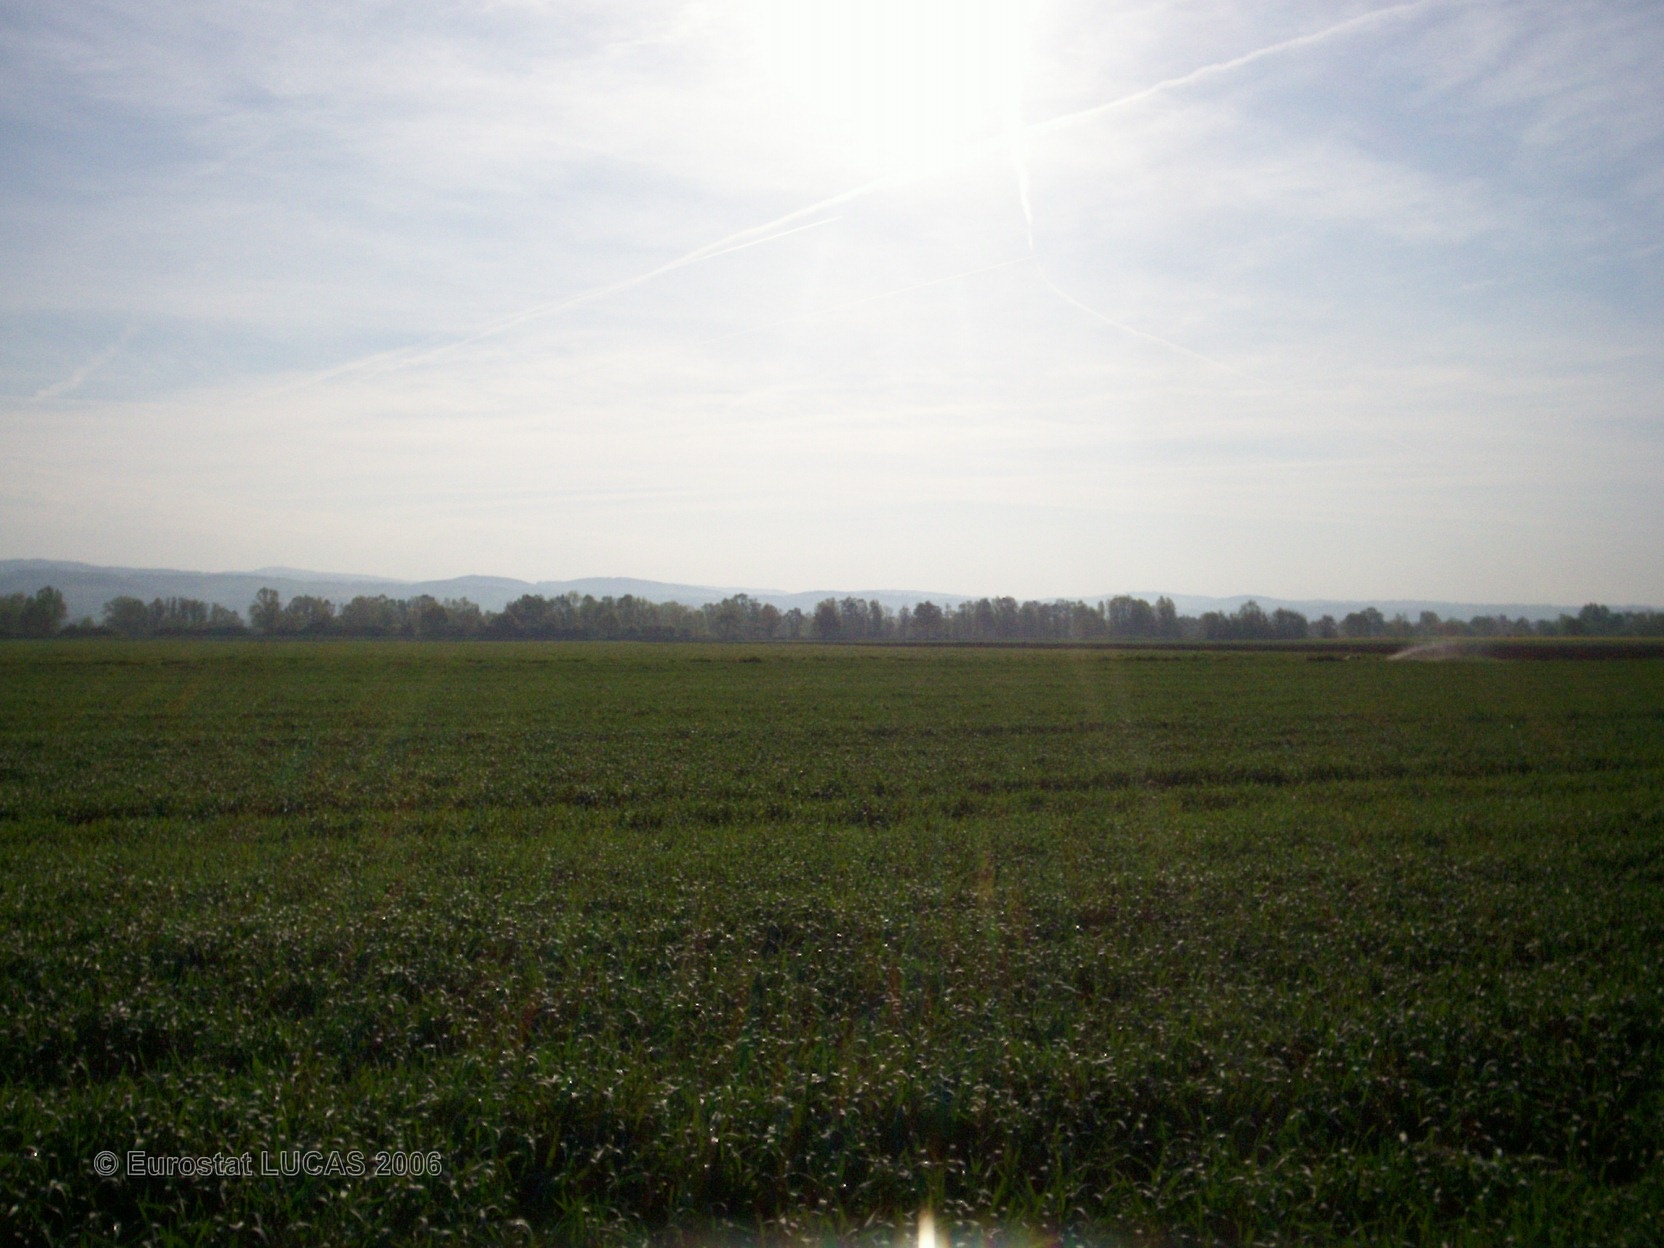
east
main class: Cropland
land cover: Common wheat
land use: Agriculture (excluding fallow land and kitchen gardens)
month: May
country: FR
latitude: 45.7951
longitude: 4.1746
